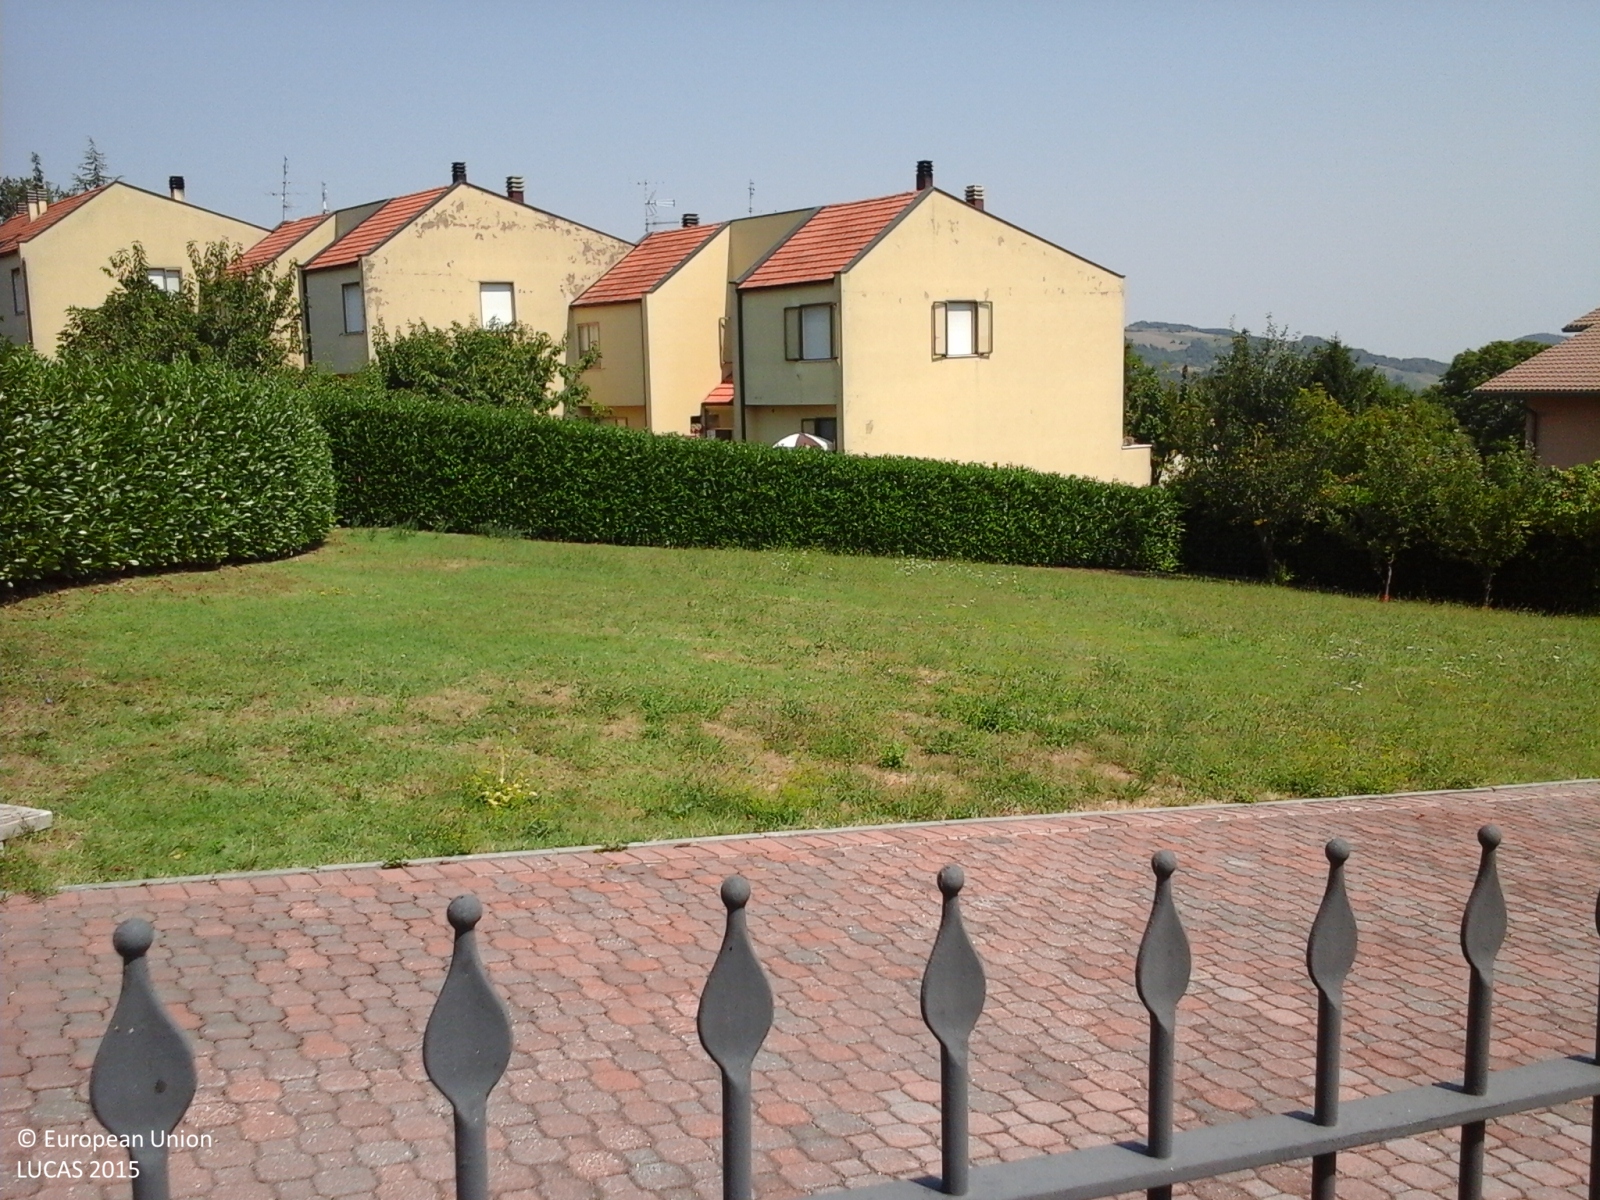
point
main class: Grassland
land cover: Grassland without tree/shrub cover
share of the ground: > 75 %
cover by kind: herbaceous plants 100 %
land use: Residential
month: August
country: IT
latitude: 43.7827
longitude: 12.3426
